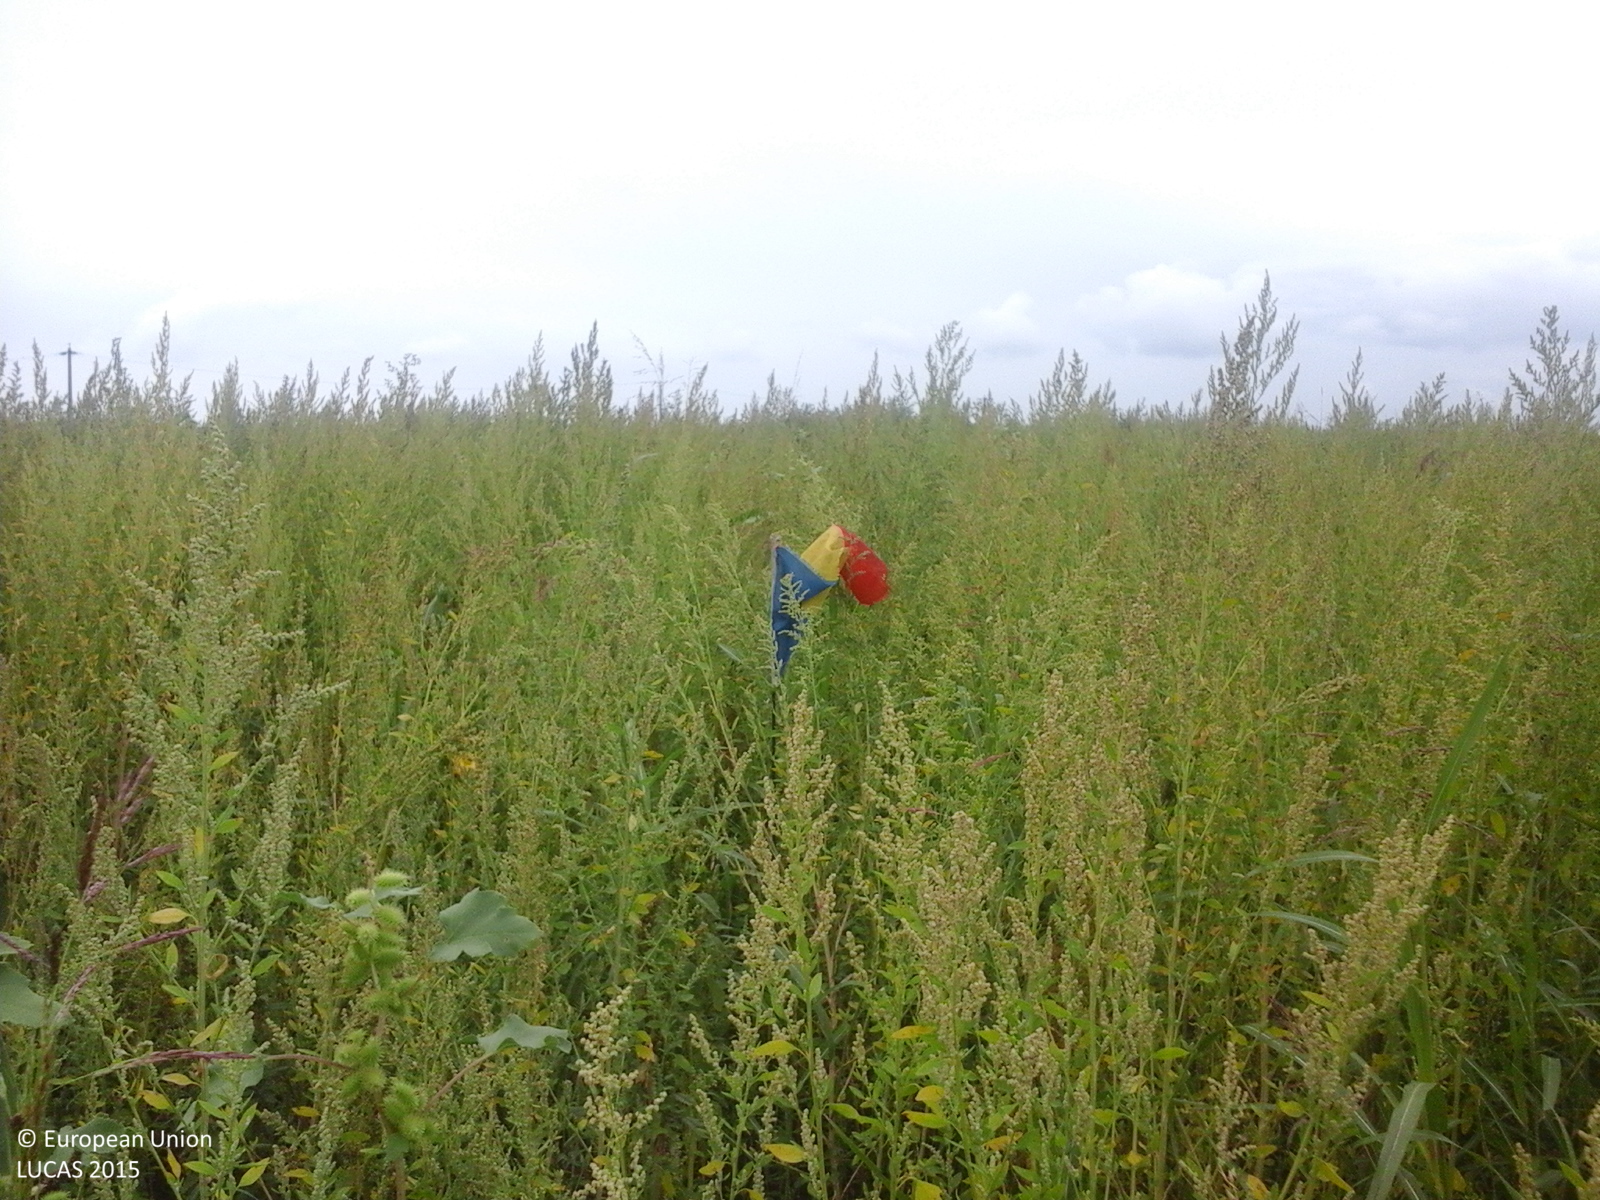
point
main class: Grassland
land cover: Spontaneously vegetated surfaces
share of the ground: > 75 %
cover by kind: herbaceous plants 100 %
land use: Agriculture (excluding fallow land and kitchen gardens)
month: September
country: RO
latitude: 47.3201
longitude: 21.9150
